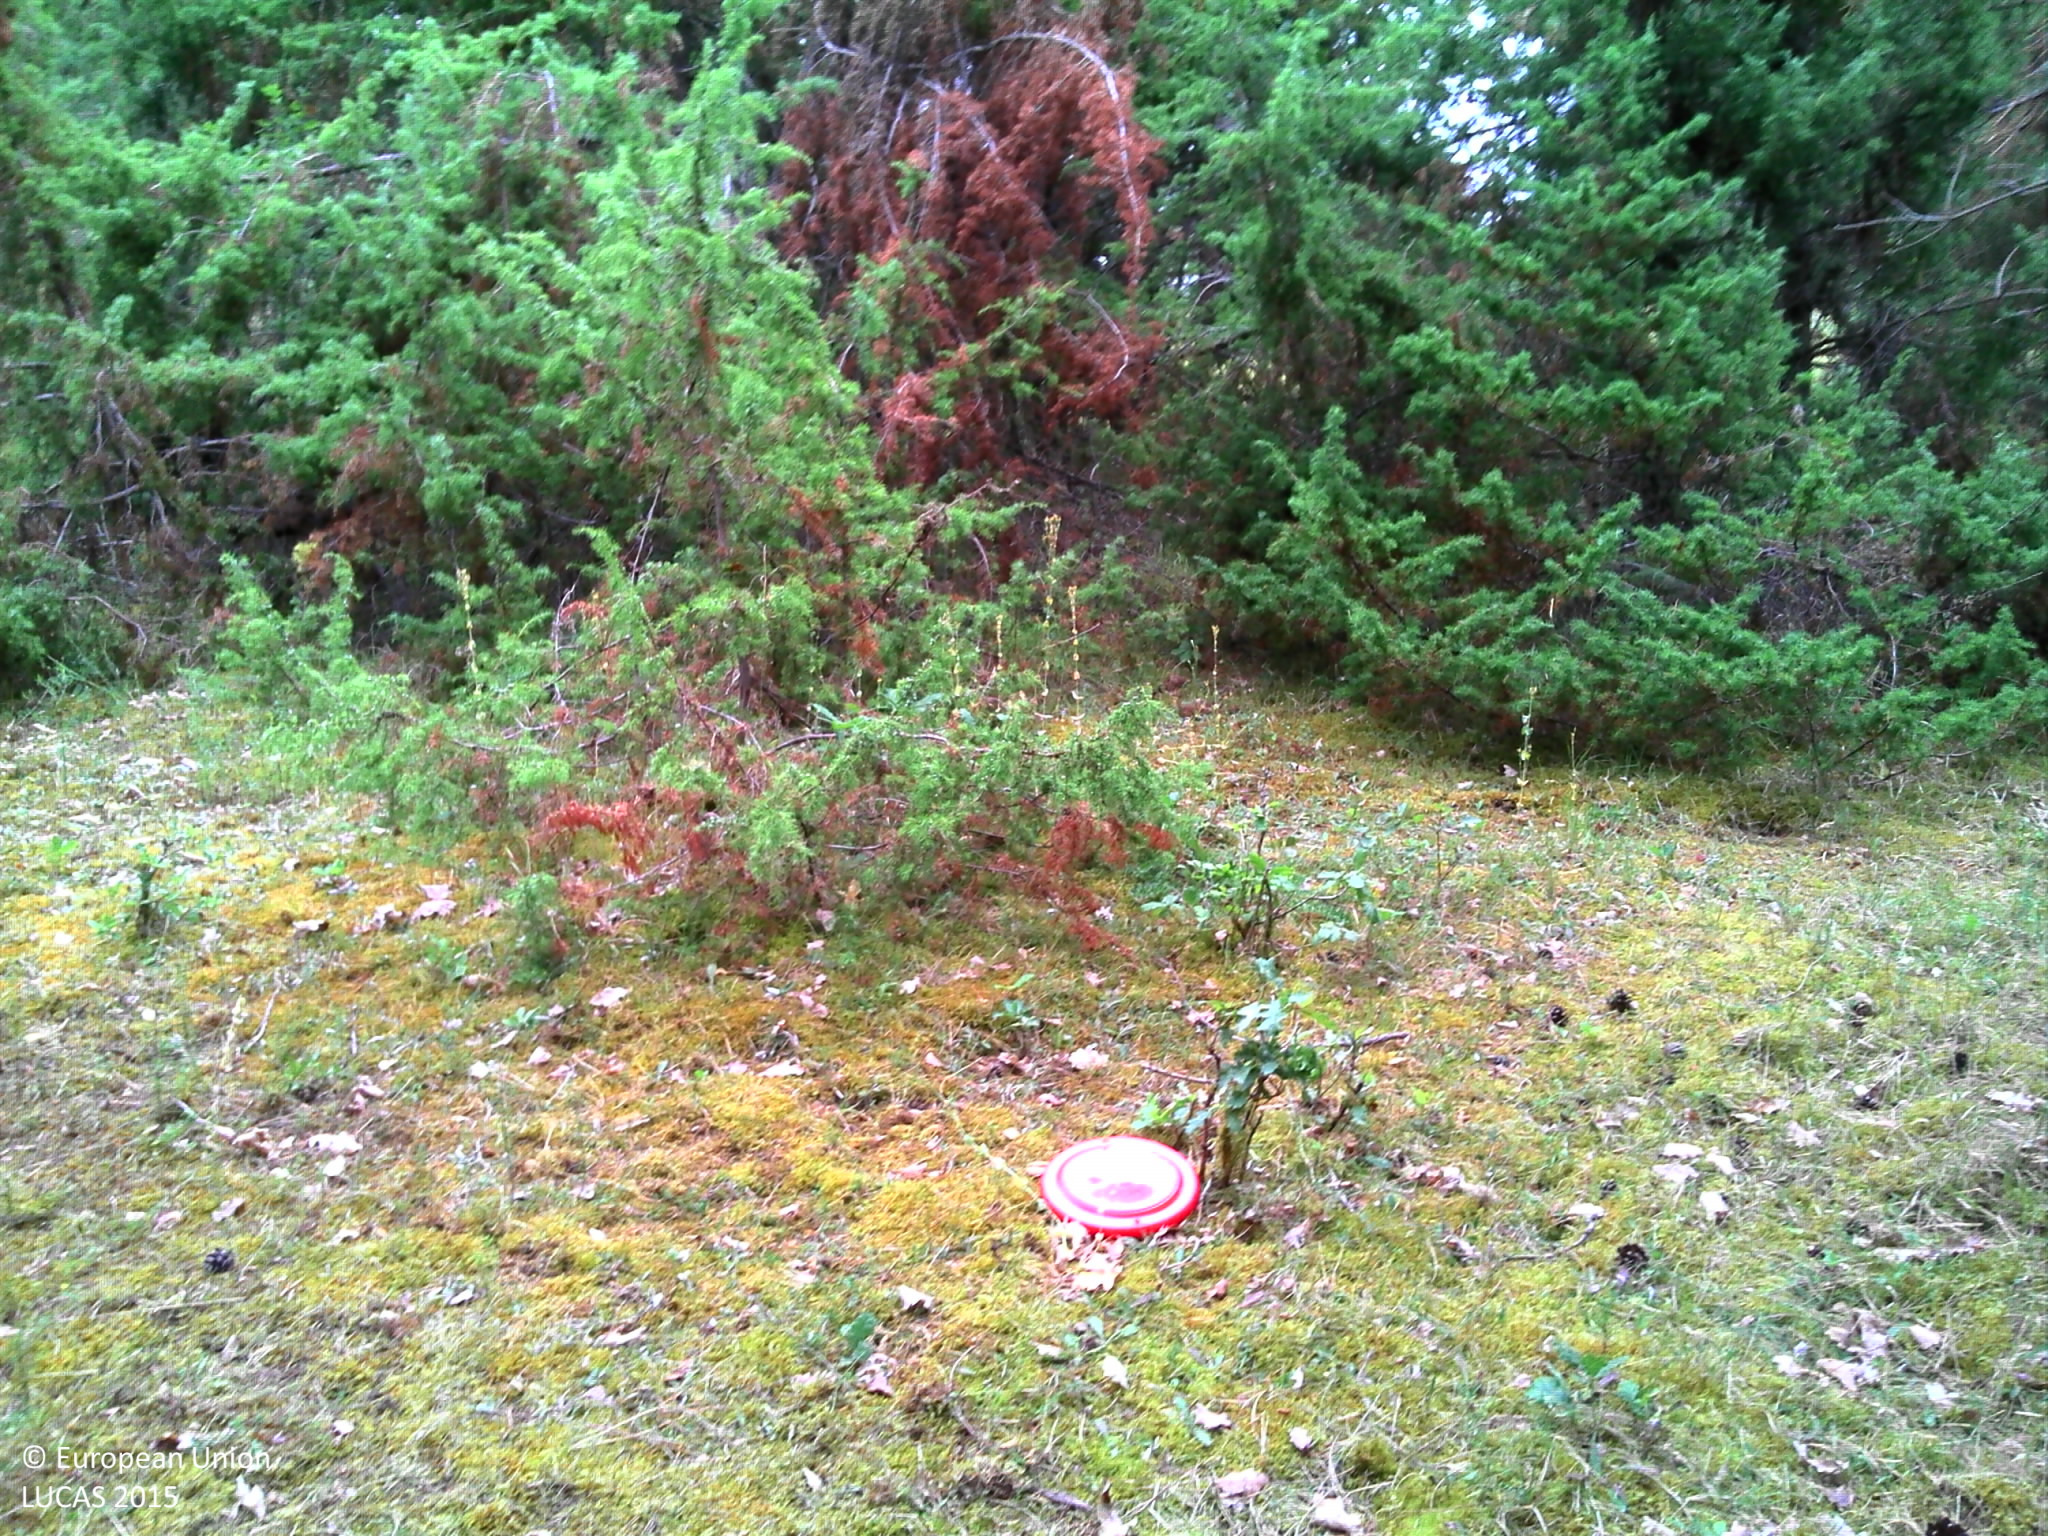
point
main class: Woodland
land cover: Pine dominated mixed woodland
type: hemiboreal forest and nemoral coniferous forest and mixed broadleaved-coniferous forest
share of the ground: > 75 %
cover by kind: broadleaved forest trees 55 %, coniferous forest trees 20 %, lichens and mosses 20 %, herbaceous plants 5 %
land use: Agriculture (excluding fallow land and kitchen gardens)
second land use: Forestry
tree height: > 5 m
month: July
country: FR
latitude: 45.1825
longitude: 0.8920
